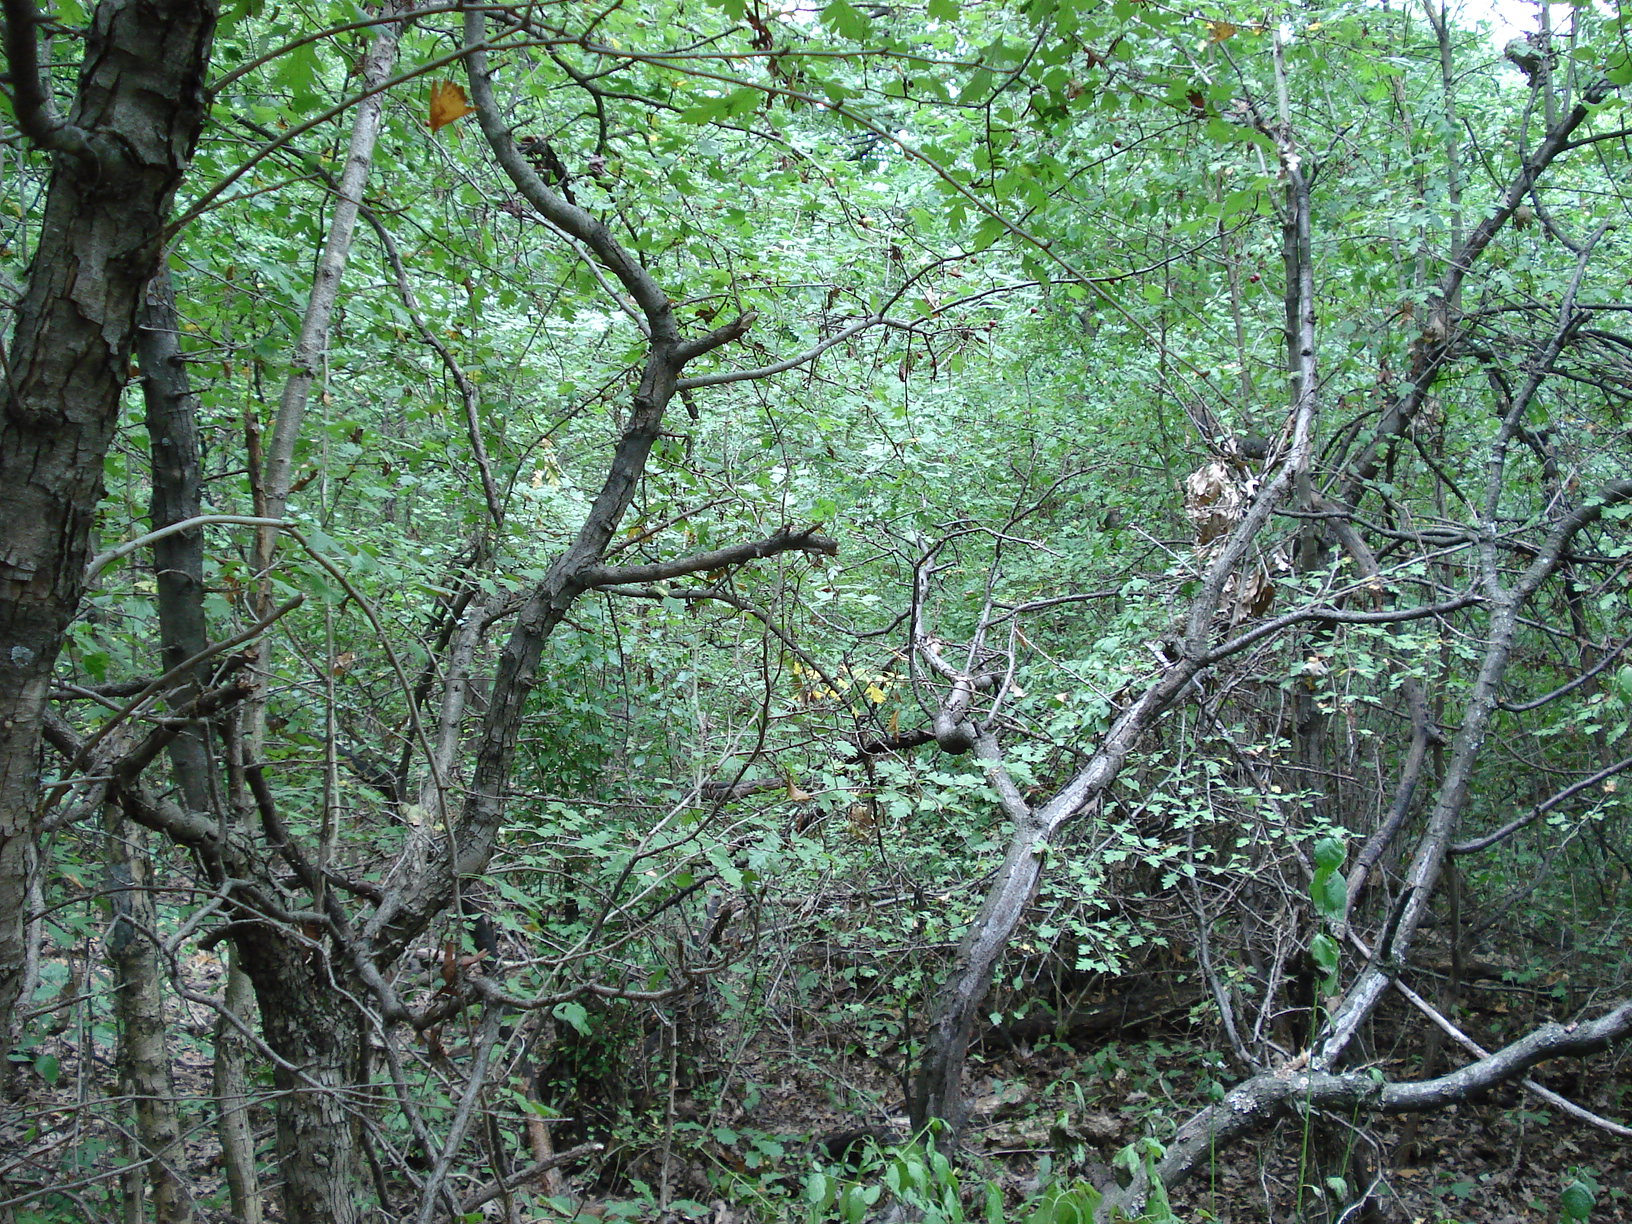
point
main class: Woodland
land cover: Broadleaved woodland
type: mesophytic deciduous forest
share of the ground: > 75 %
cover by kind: broadleaved forest trees 85 %, herbaceous plants 10 %, shrubs 5 %
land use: Forestry
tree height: > 5 m
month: September
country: BG
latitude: 43.0456
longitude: 25.7583
